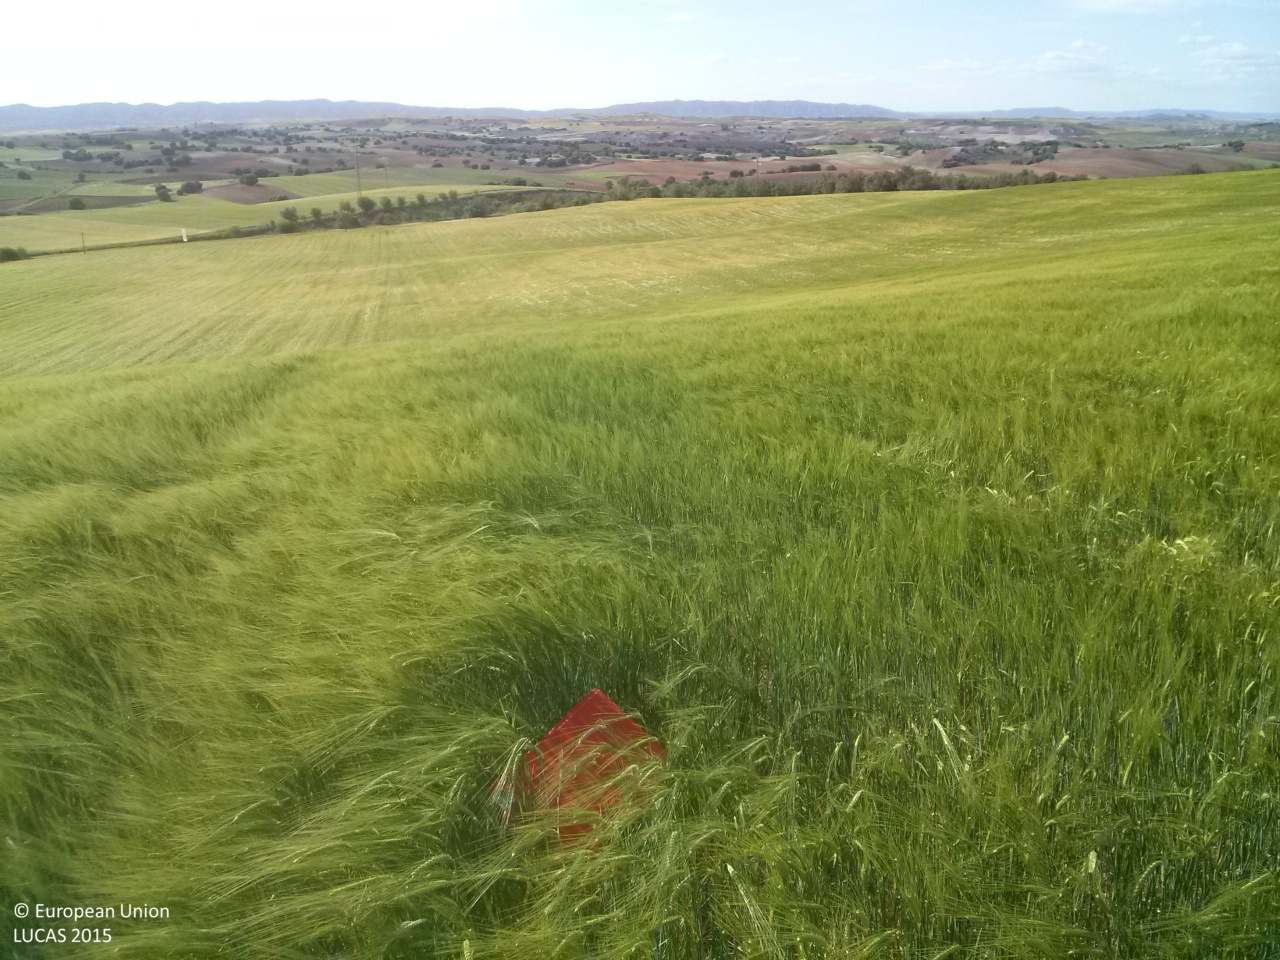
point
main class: Cropland
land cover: Barley
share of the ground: > 75 %
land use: Agriculture (excluding fallow land and kitchen gardens)
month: May
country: ES
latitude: 40.0966
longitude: -2.7015
